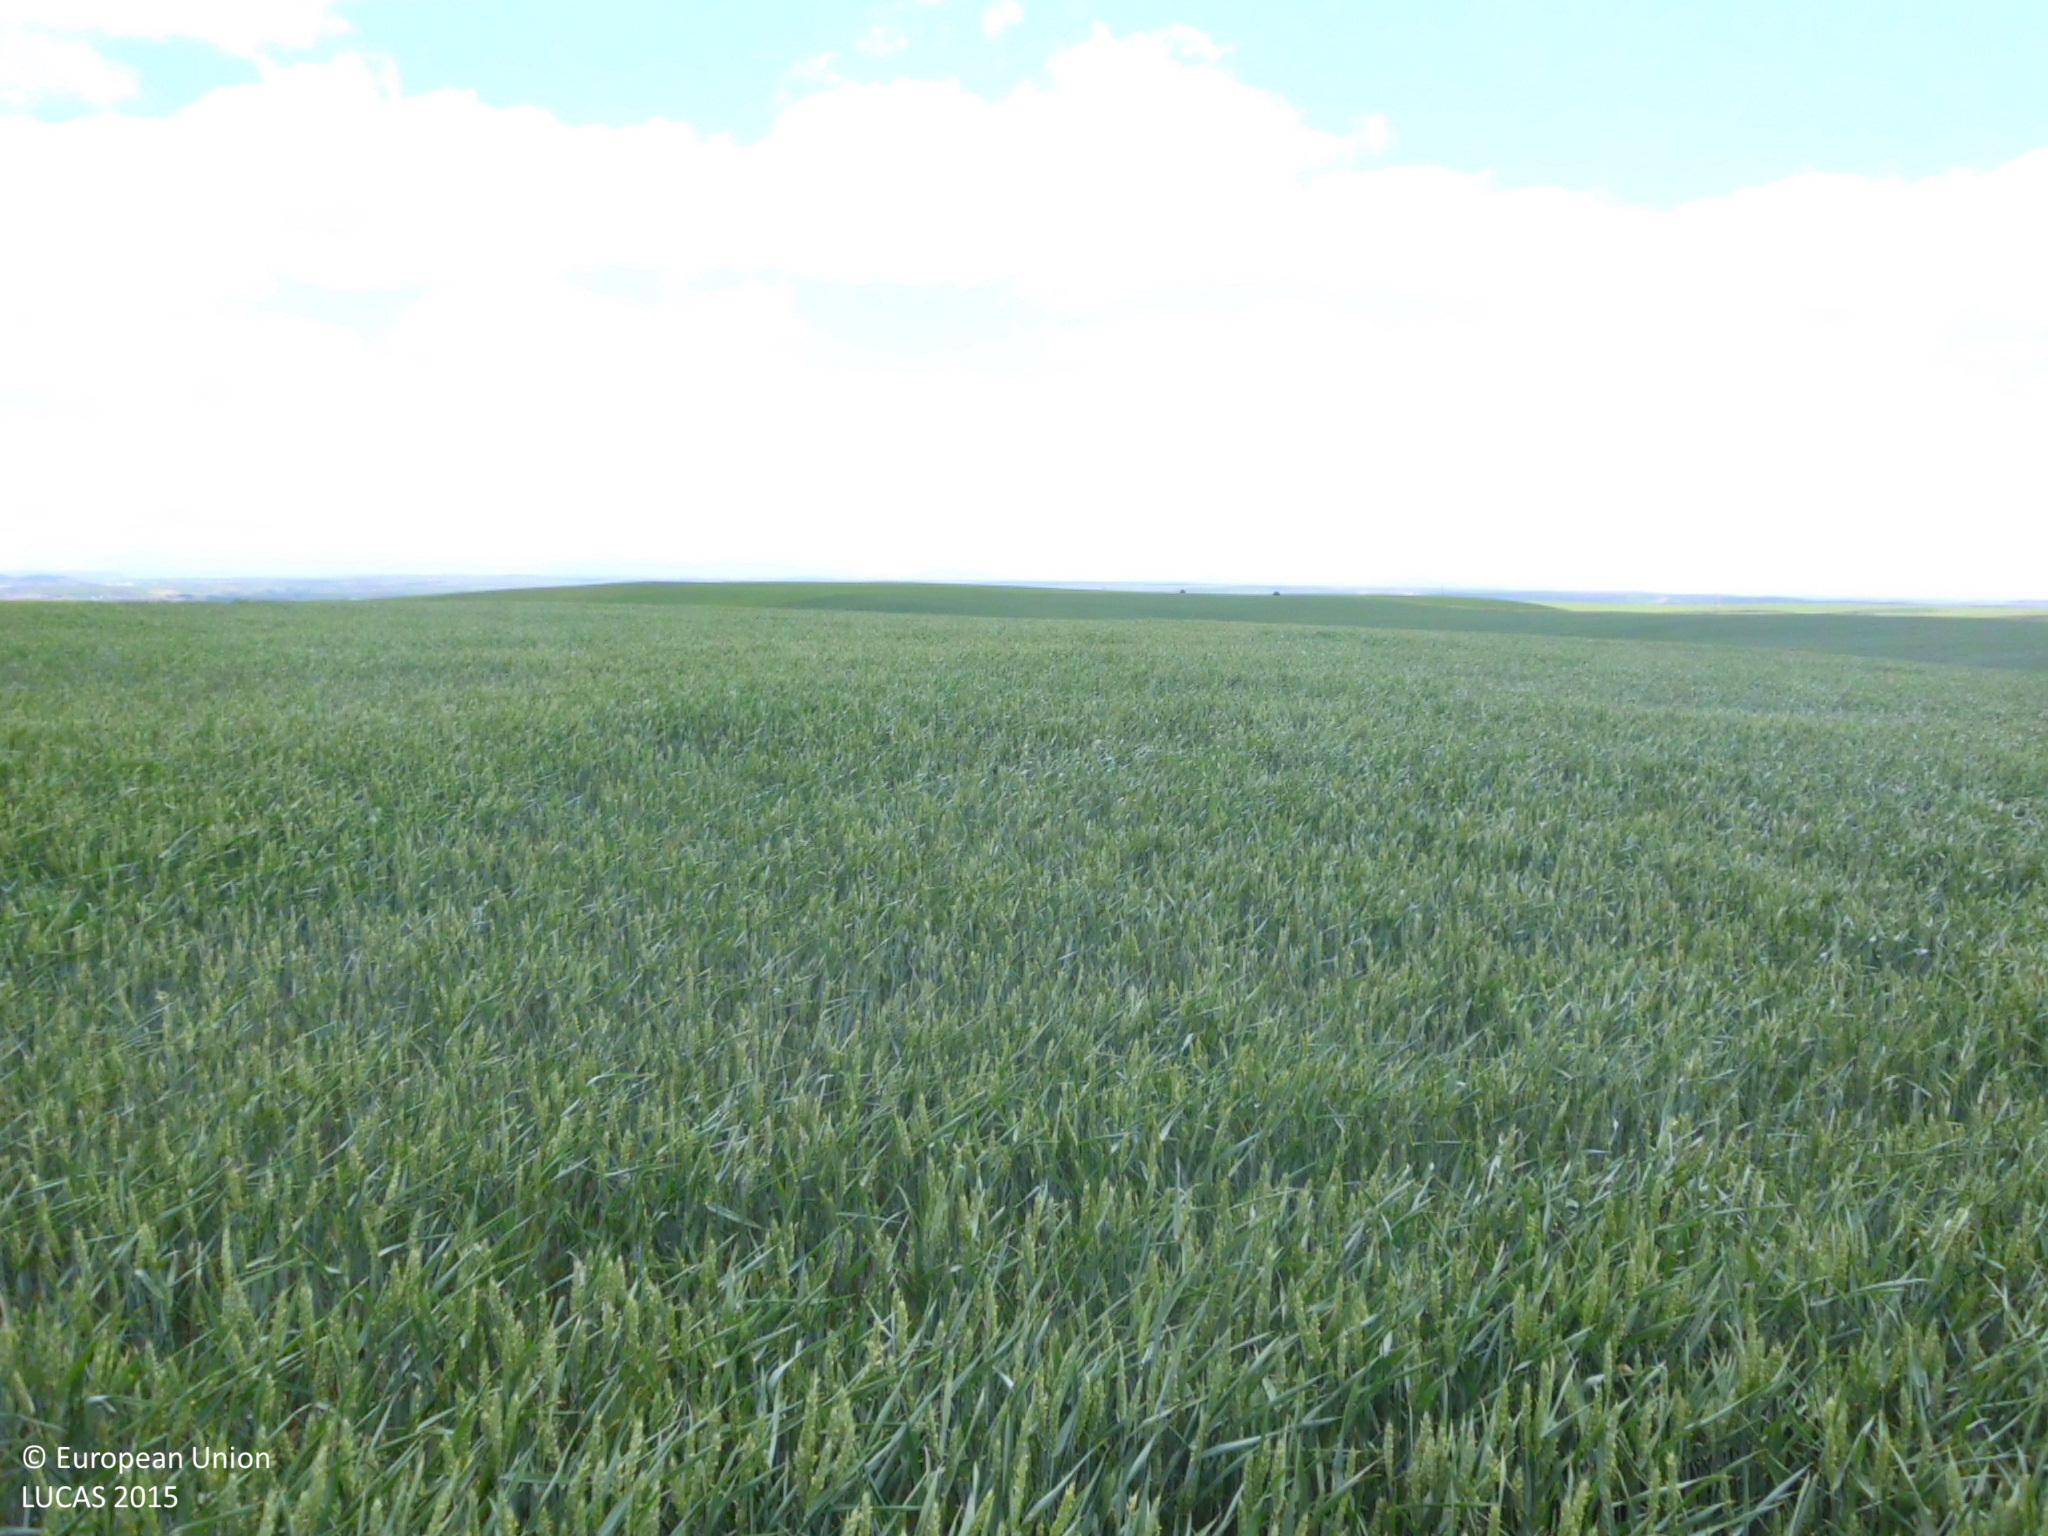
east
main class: Cropland
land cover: Common wheat
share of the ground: > 75 %
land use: Agriculture (excluding fallow land and kitchen gardens)
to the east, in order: Common wheat; Barley; Grass margins; Common wheat
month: May
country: ES
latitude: 42.3359
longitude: -3.8626
